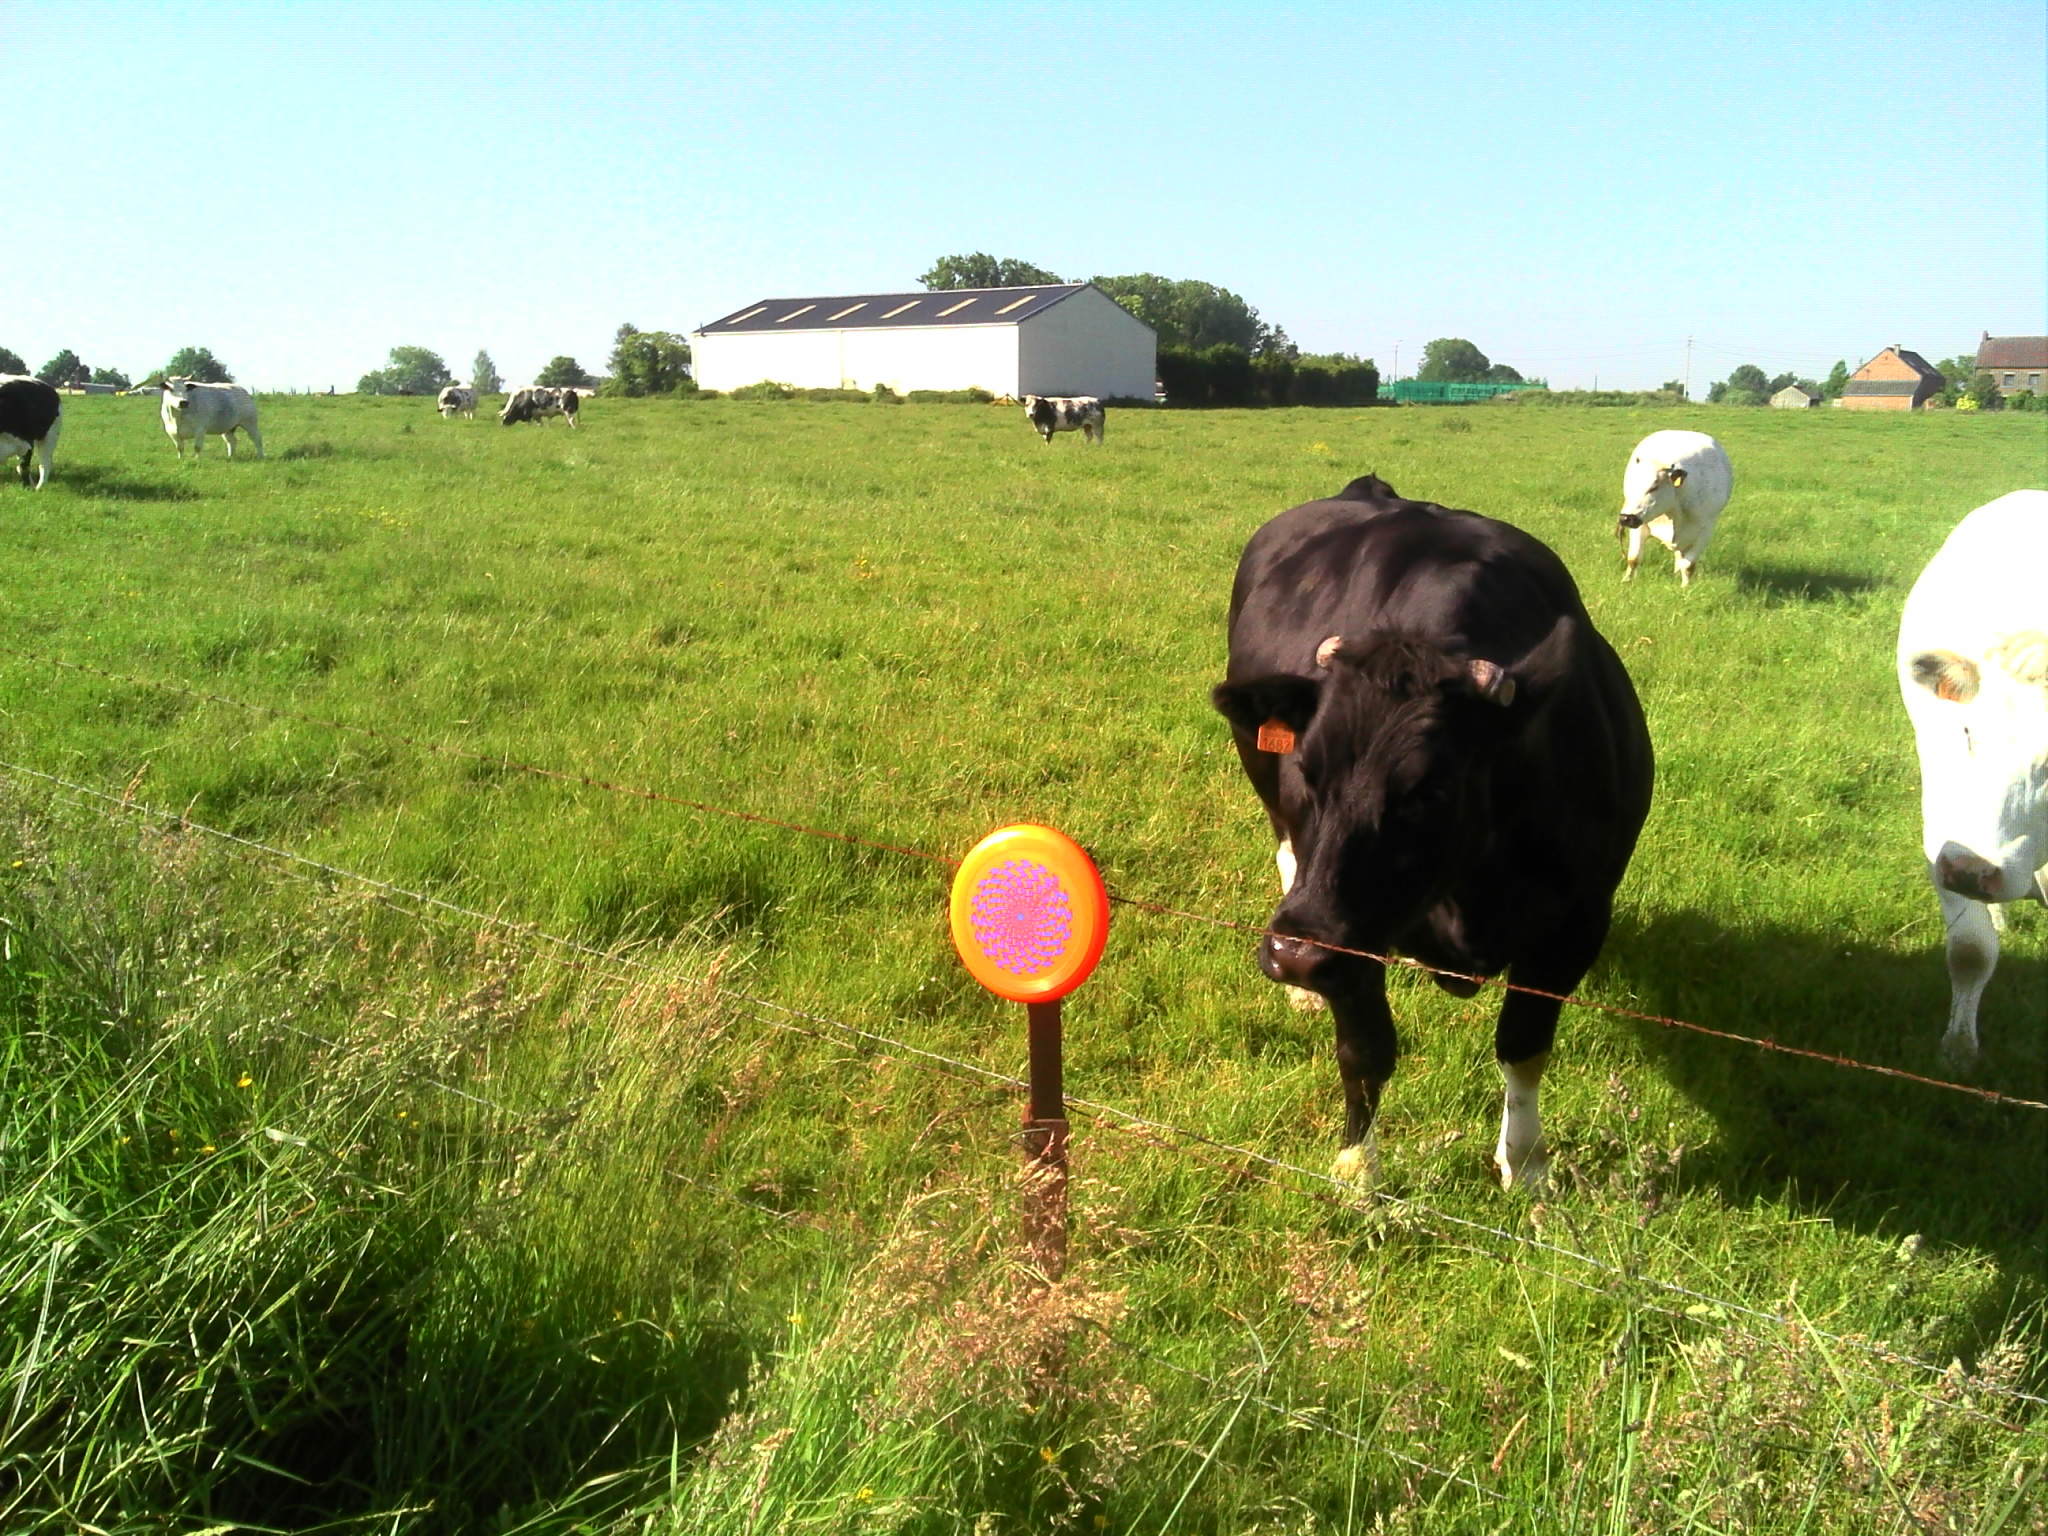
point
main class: Grassland
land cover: Grassland without tree/shrub cover
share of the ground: > 75 %
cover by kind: herbaceous plants 100 %
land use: Agriculture (excluding fallow land and kitchen gardens)
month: June
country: BE
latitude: 50.5516
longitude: 4.7886
